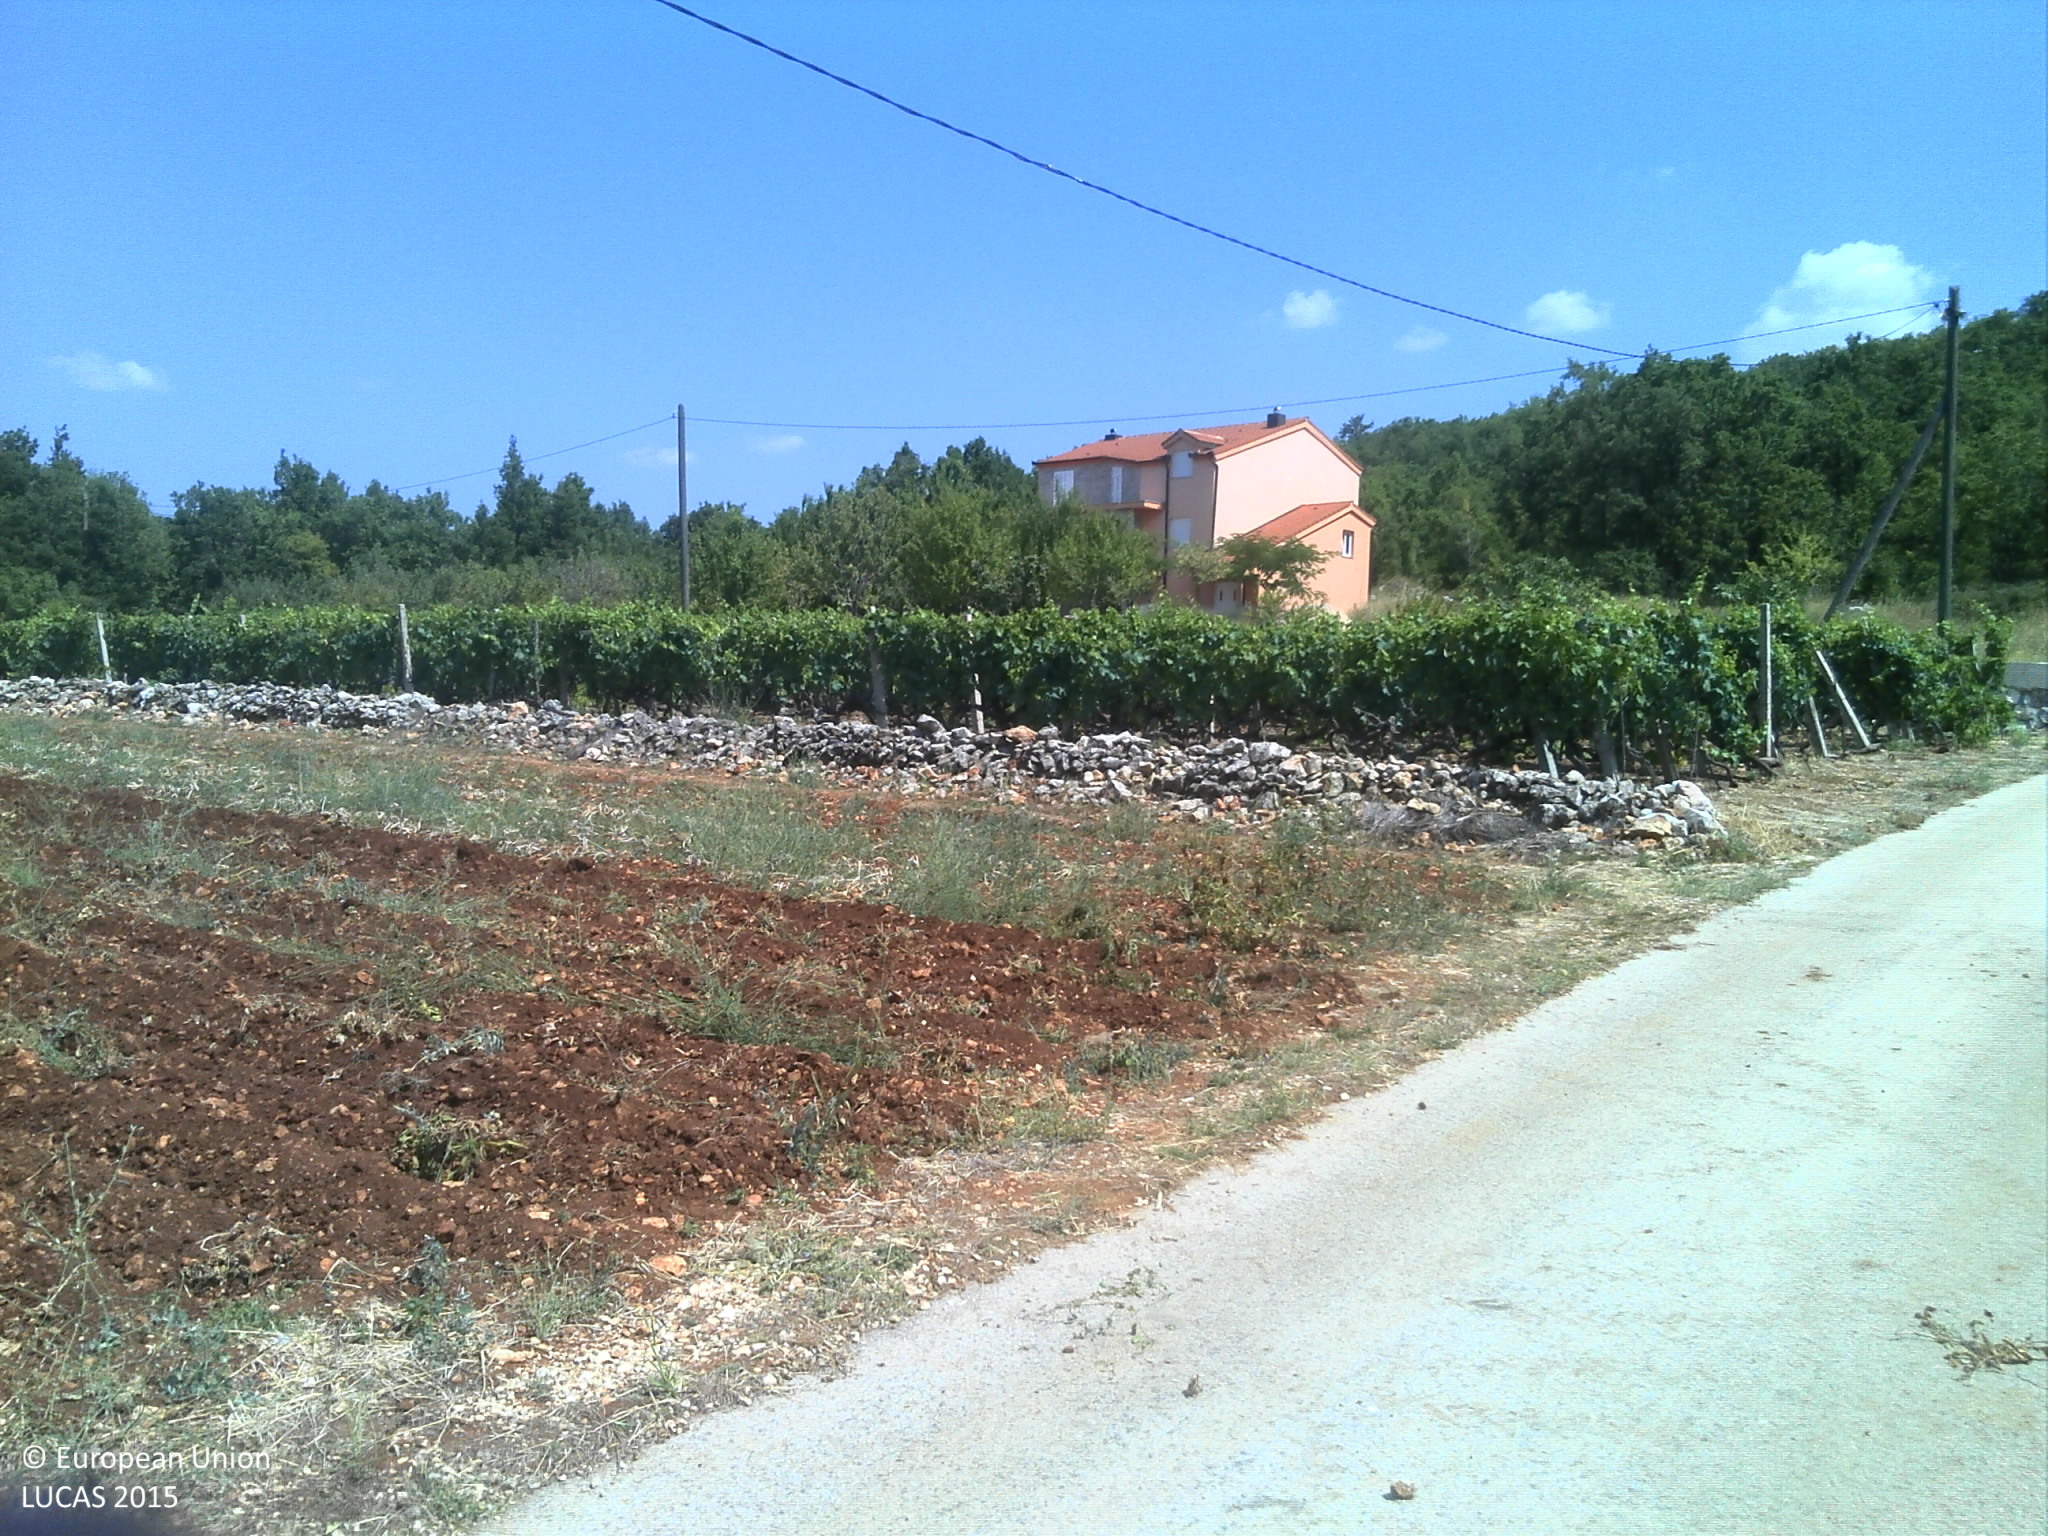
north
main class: Cropland
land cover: Vineyards
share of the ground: > 75 %
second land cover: Other bare soil
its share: > 75 %
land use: Agriculture (excluding fallow land and kitchen gardens)
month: July
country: HR
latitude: 43.4435
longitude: 17.2697
